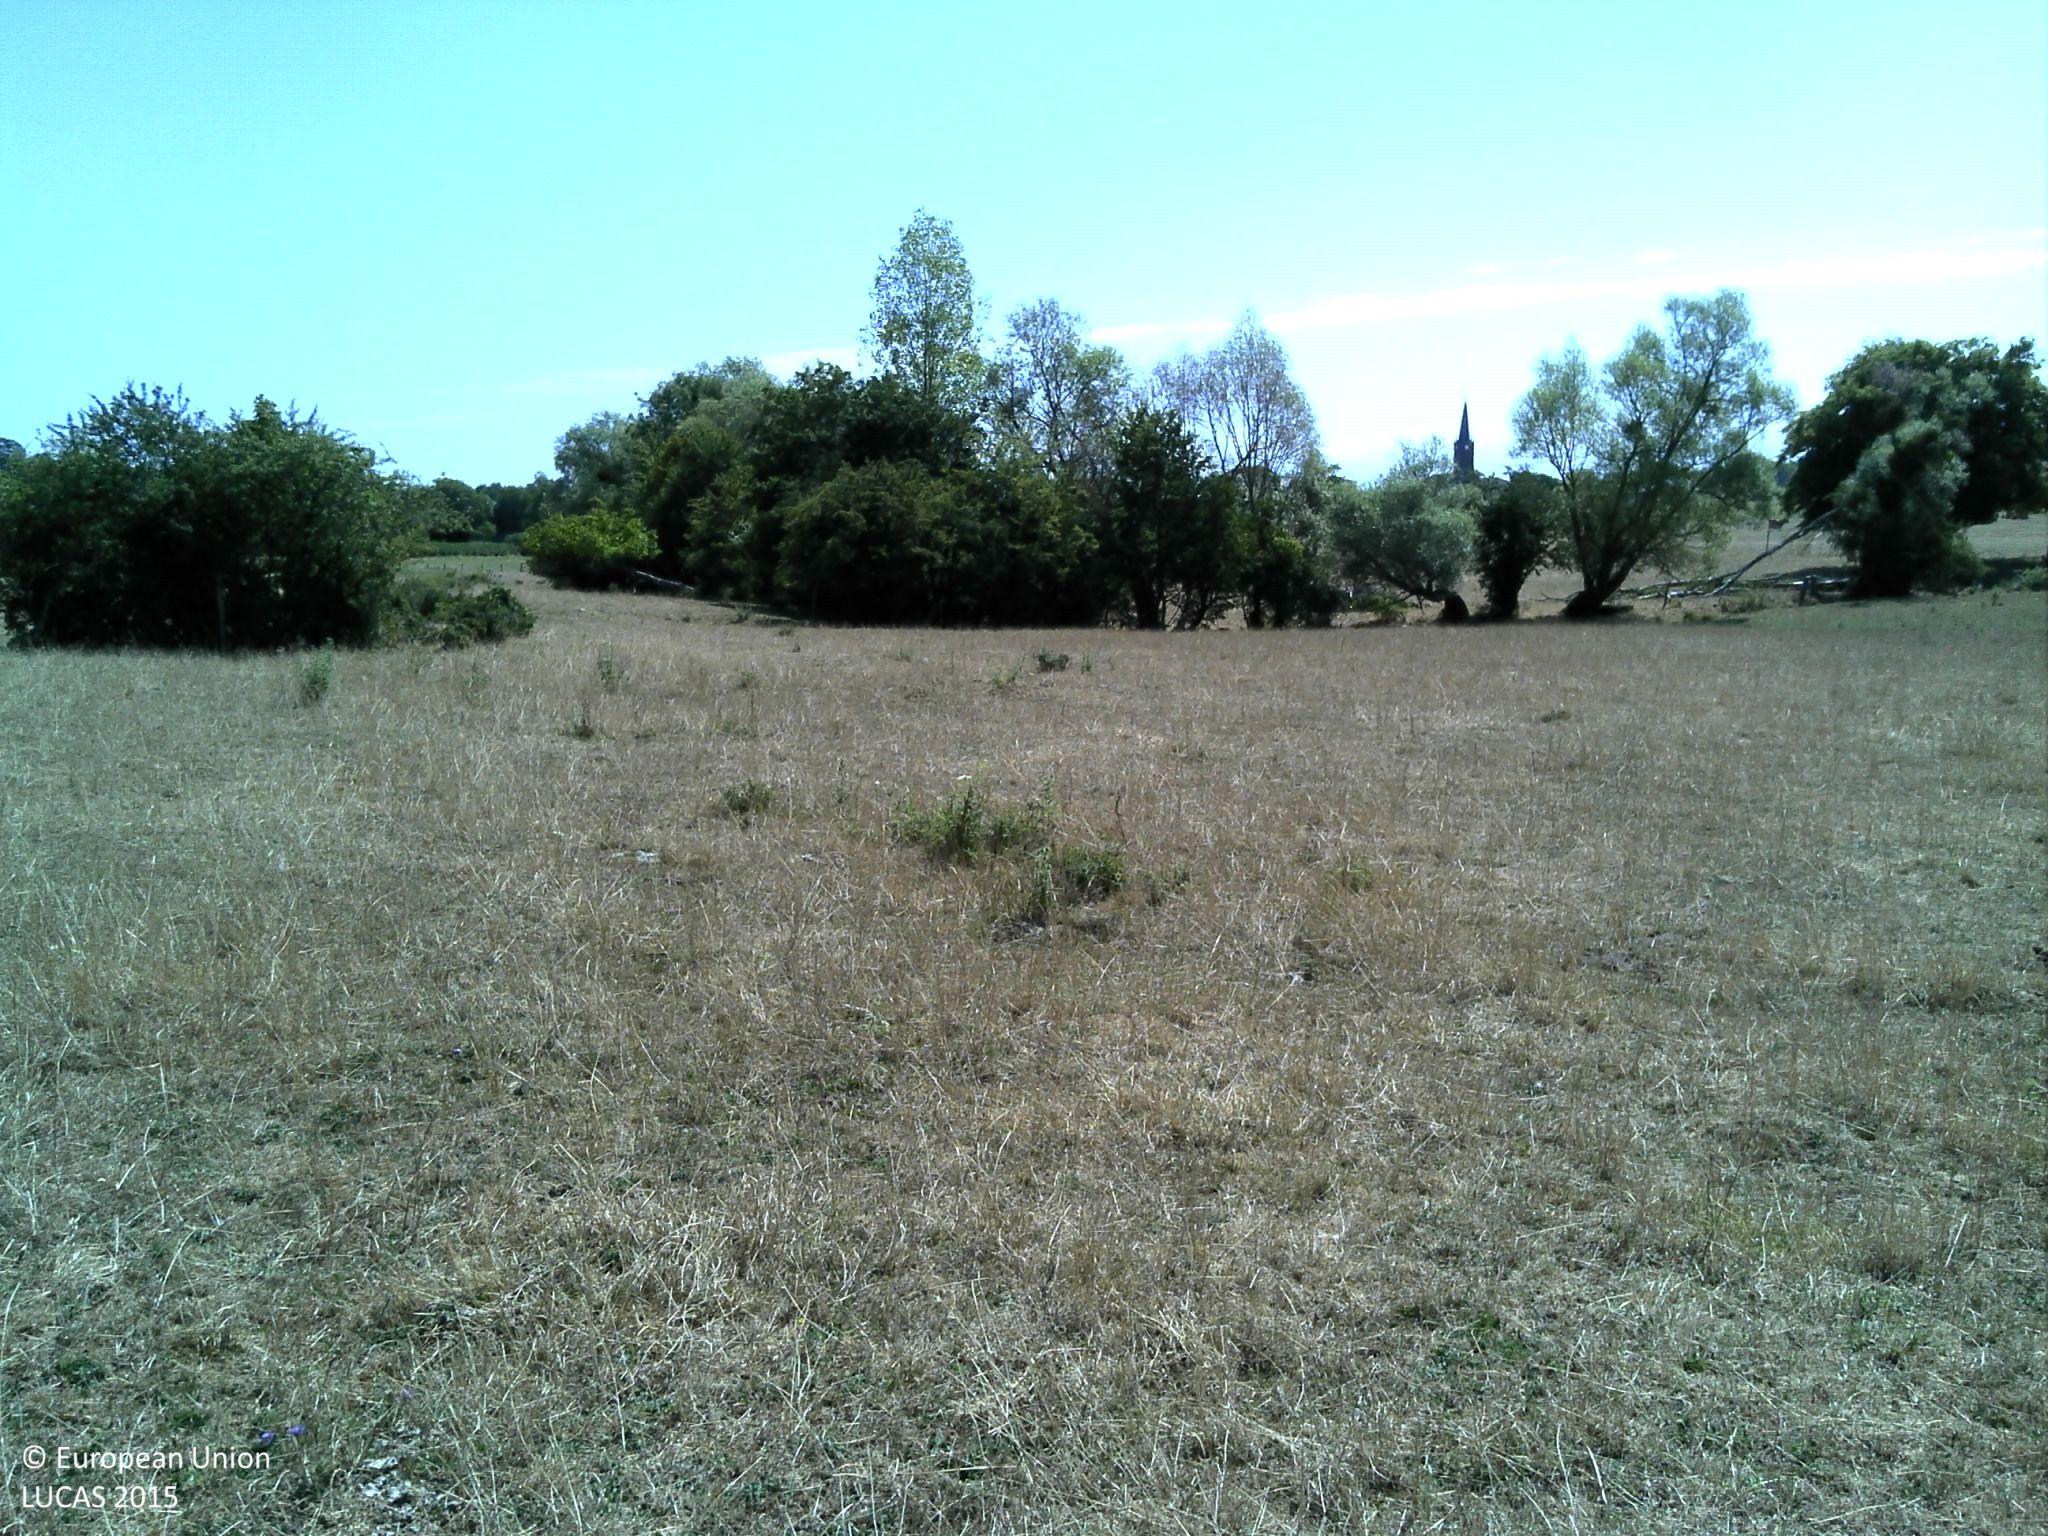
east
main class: Grassland
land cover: Grassland with sparse tree/shrub cover
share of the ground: > 75 %
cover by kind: herbaceous plants 95 %, broadleaved forest trees 5 %
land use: Agriculture (excluding fallow land and kitchen gardens)
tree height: < 5 m
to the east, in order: Grassland with sparse tree/shrub cover; Lines of trees; Rivers and streams; Lines of trees; Grassland without tree/shrub cover
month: July
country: FR
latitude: 48.3329
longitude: 6.0478
